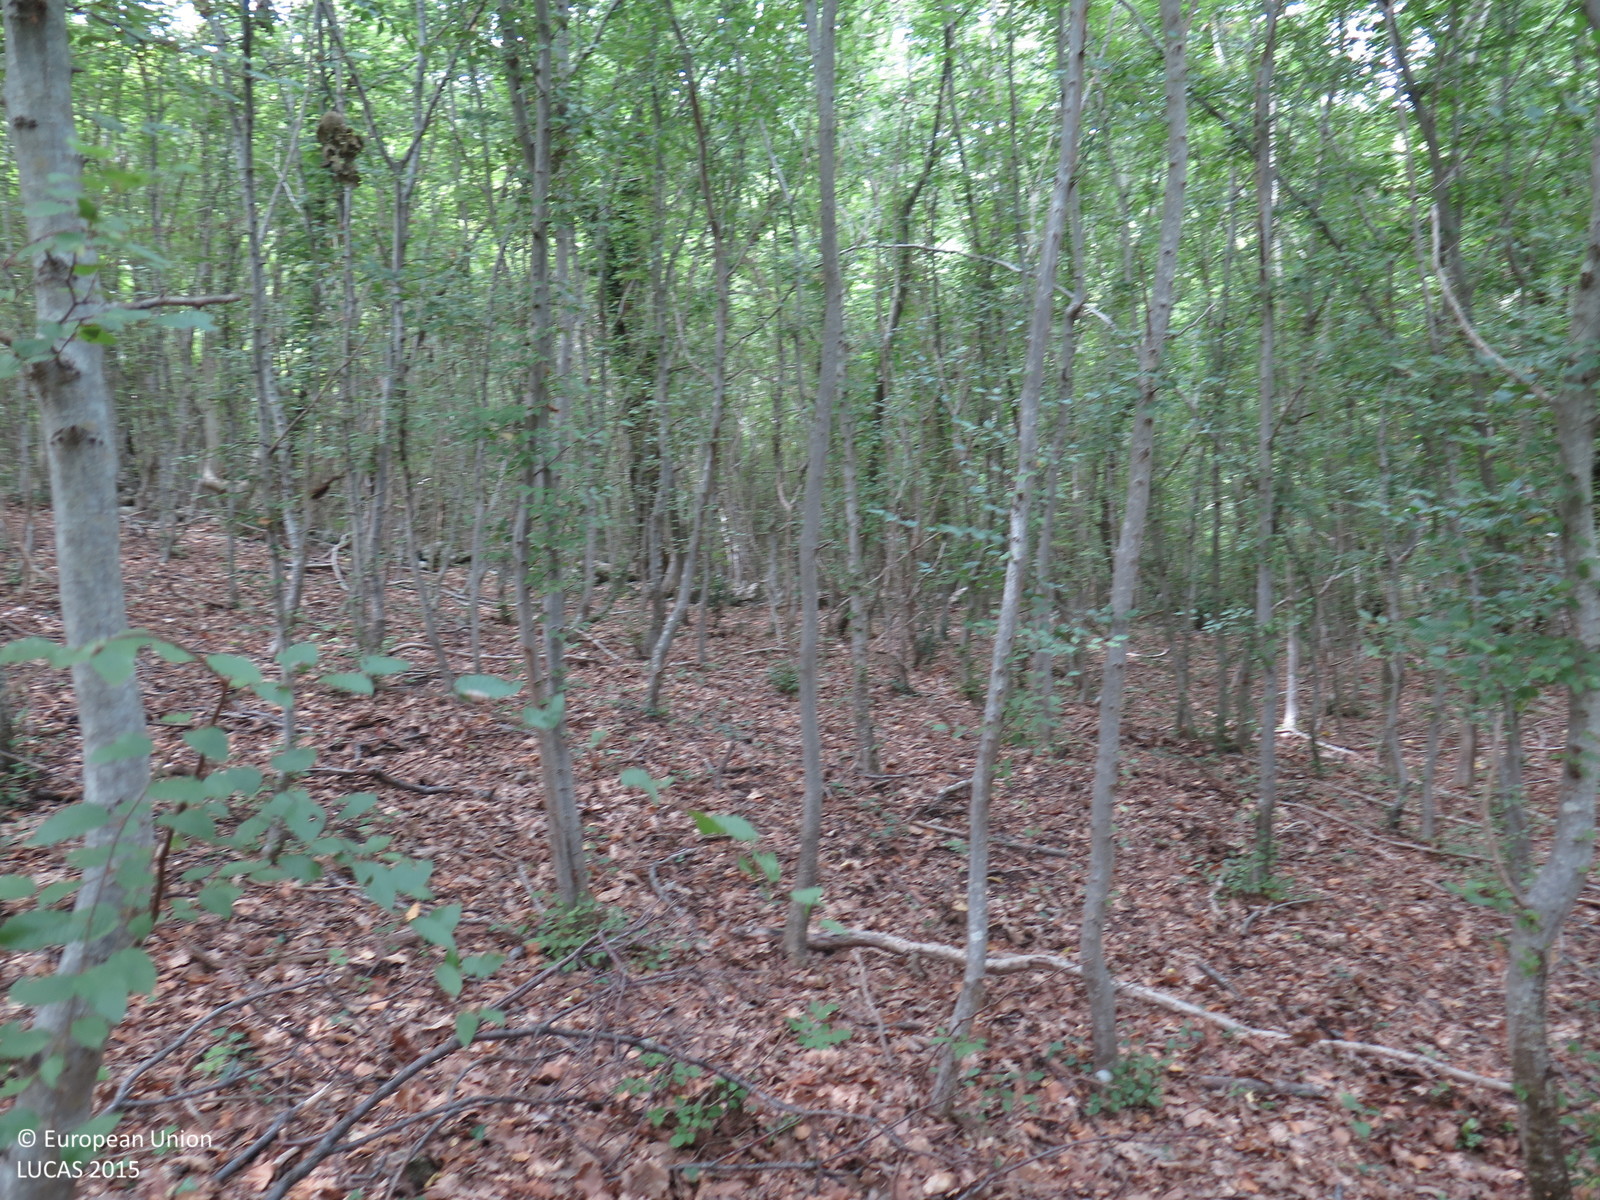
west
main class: Woodland
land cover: Broadleaved woodland
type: beech forest
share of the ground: > 75 %
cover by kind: broadleaved forest trees 100 %
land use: Forestry
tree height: > 5 m
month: August
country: HR
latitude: 45.1521
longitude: 14.5863
